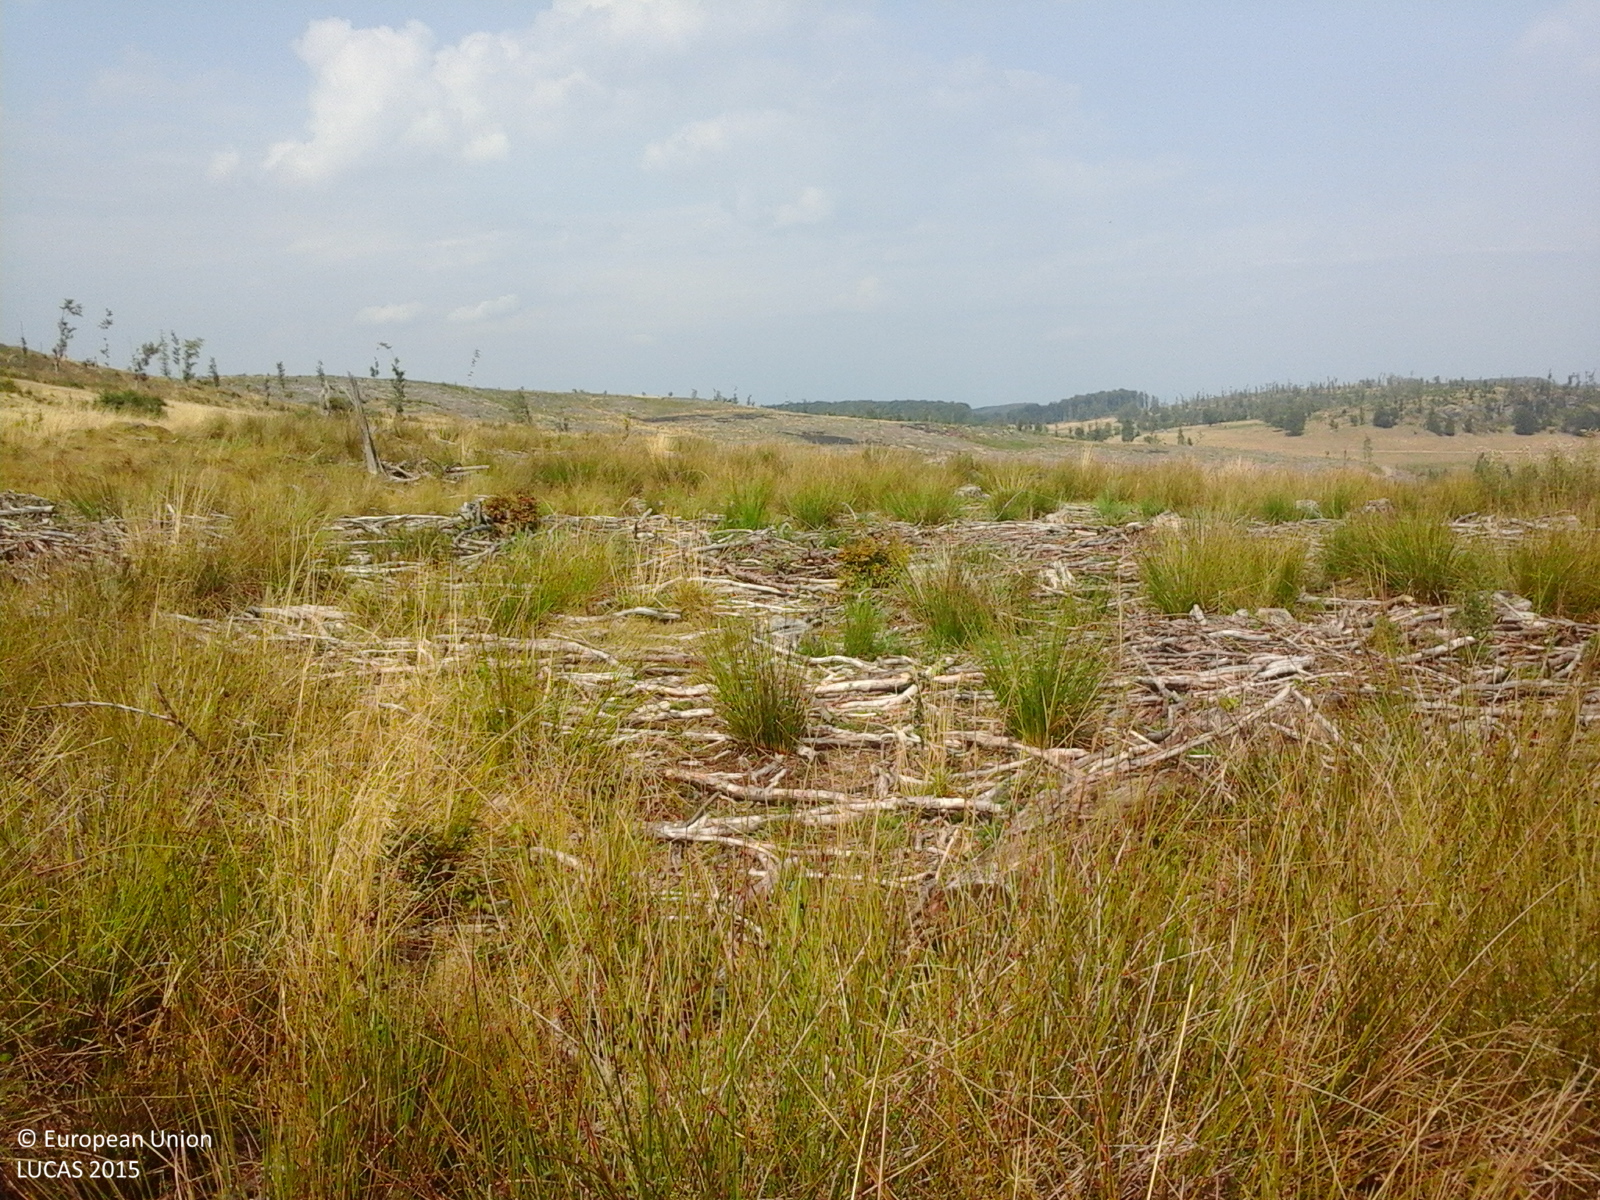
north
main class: Grassland
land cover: Spontaneously vegetated surfaces
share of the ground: > 75 %
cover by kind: herbaceous plants 100 %
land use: Forestry
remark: Clear cut
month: September
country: RO
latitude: 47.8561
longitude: 23.6990
